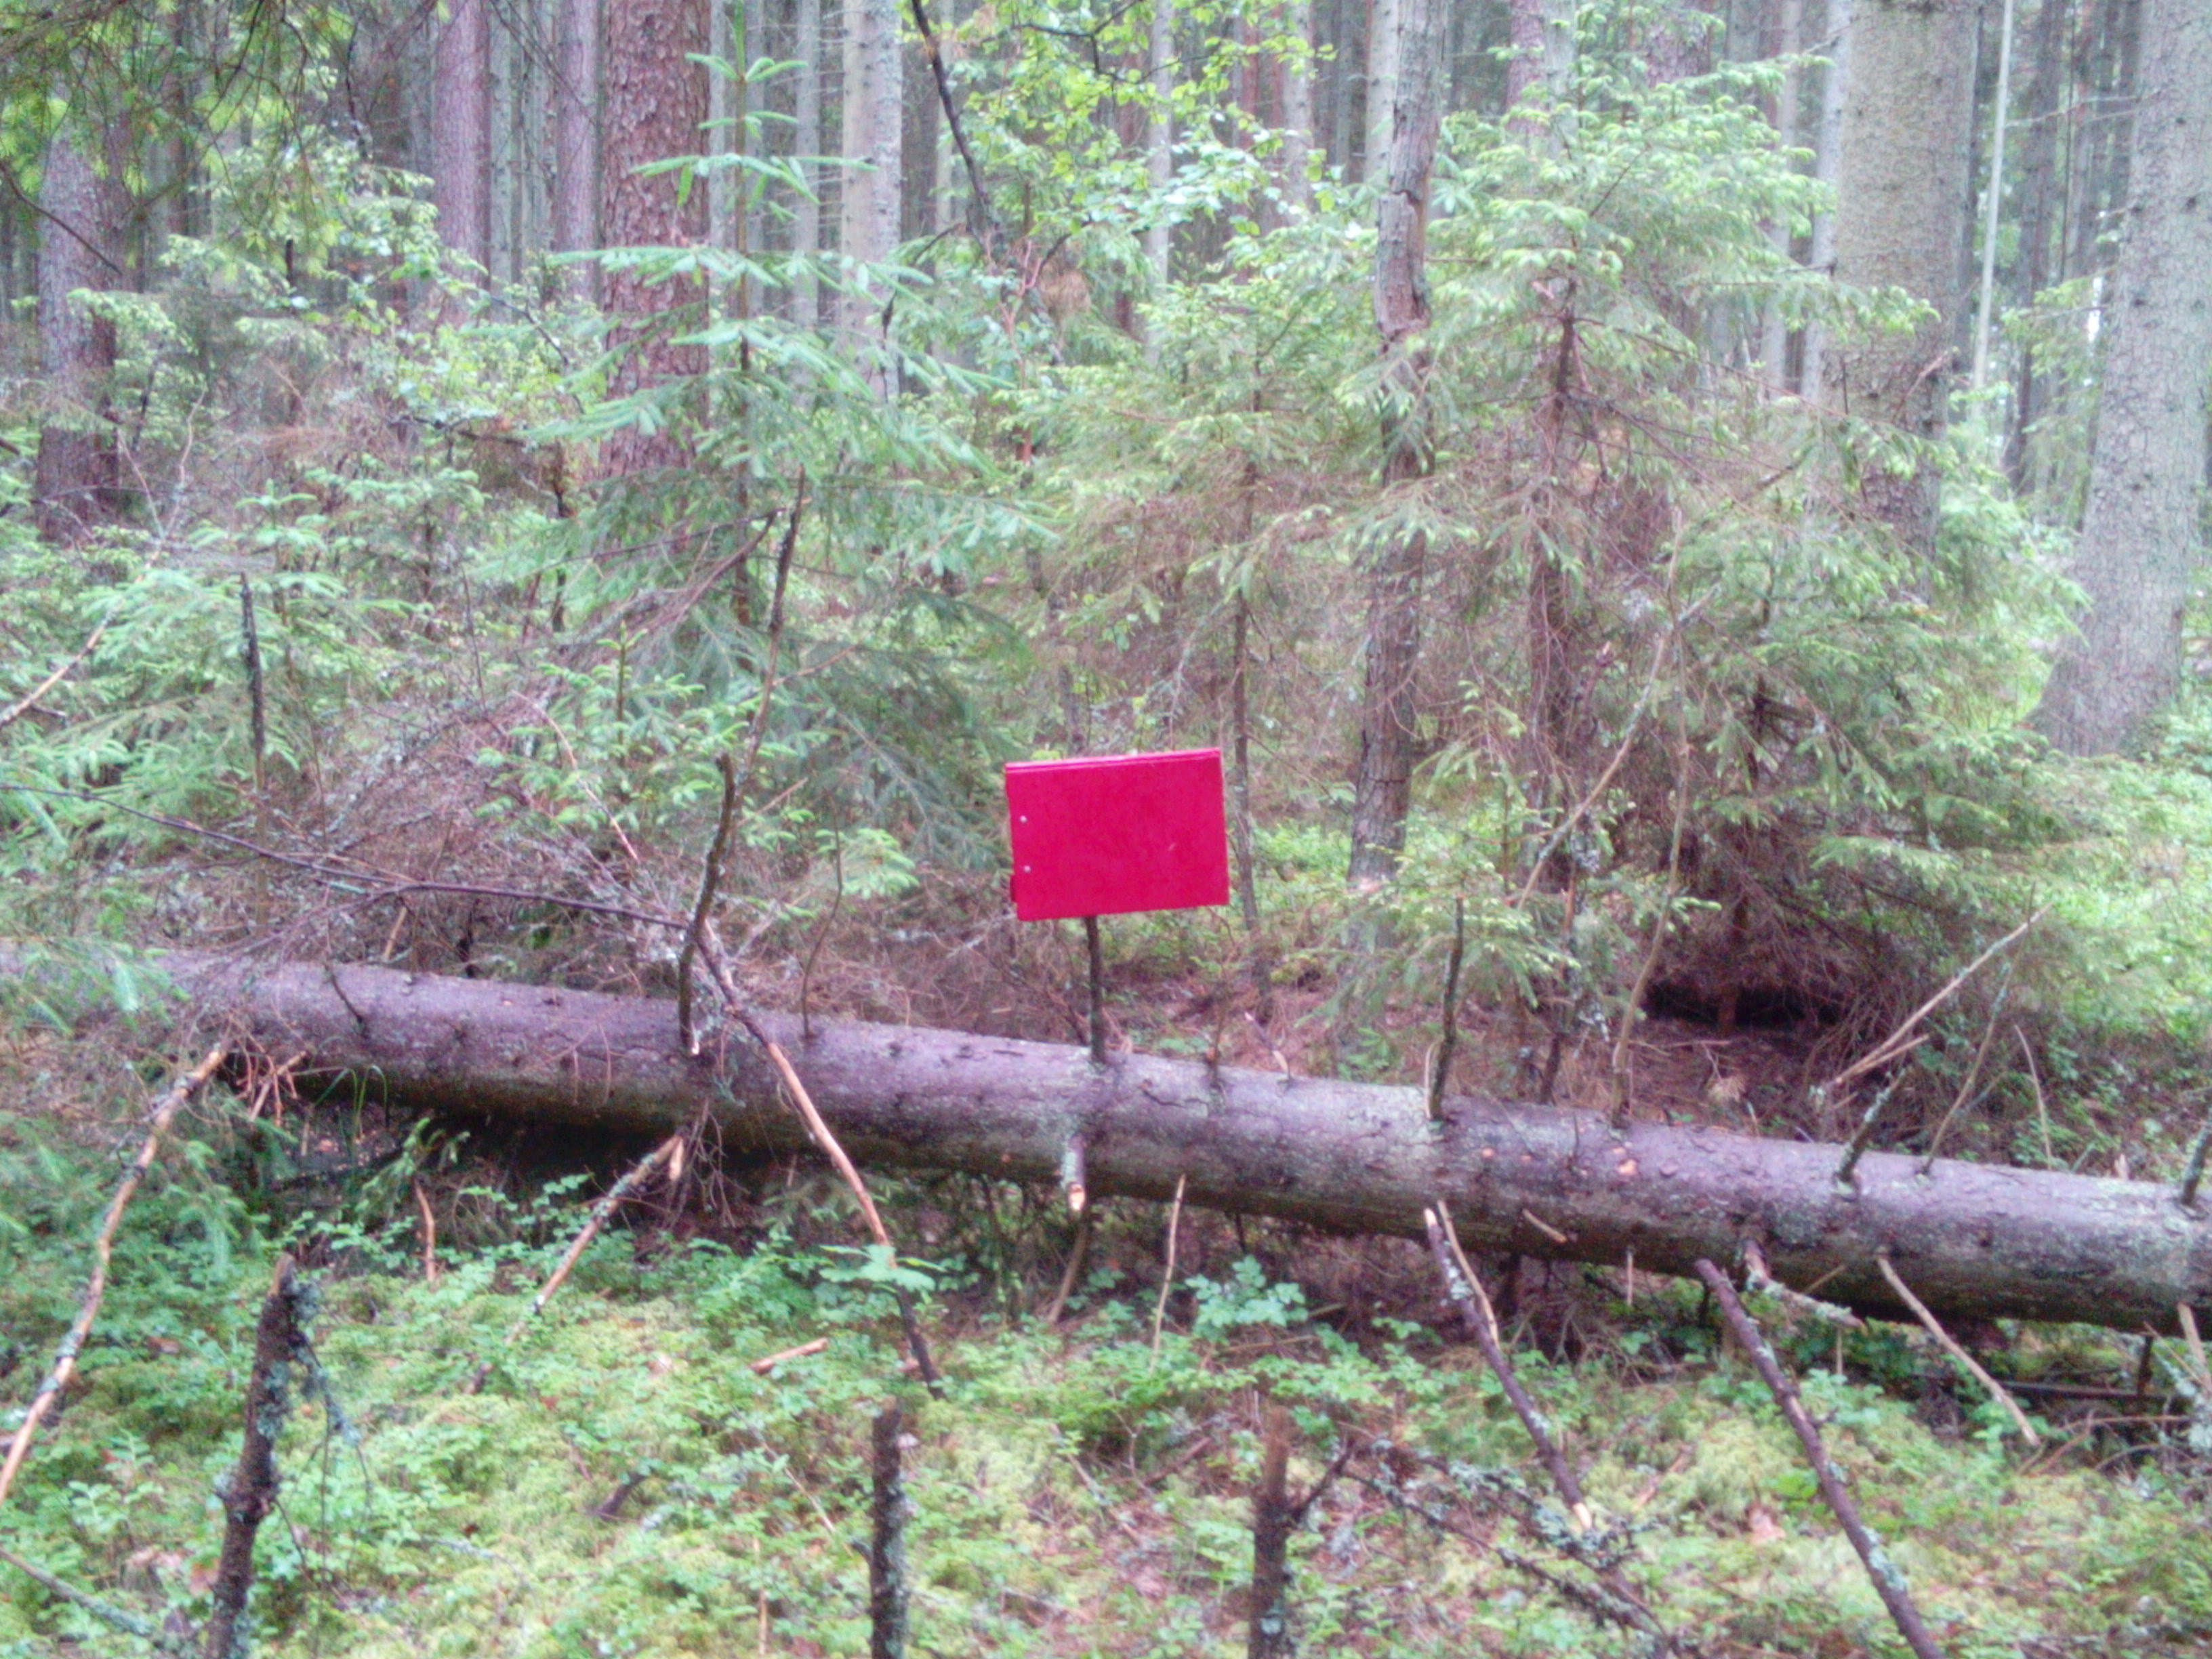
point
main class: Woodland
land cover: Other coniferous woodland
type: hemiboreal forest and nemoral coniferous forest and mixed broadleaved-coniferous forest
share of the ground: > 75 %
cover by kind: coniferous forest trees 90 %, herbaceous plants 10 %
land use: Forestry
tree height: > 5 m
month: June
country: LV
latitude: 56.7712
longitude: 21.9761
